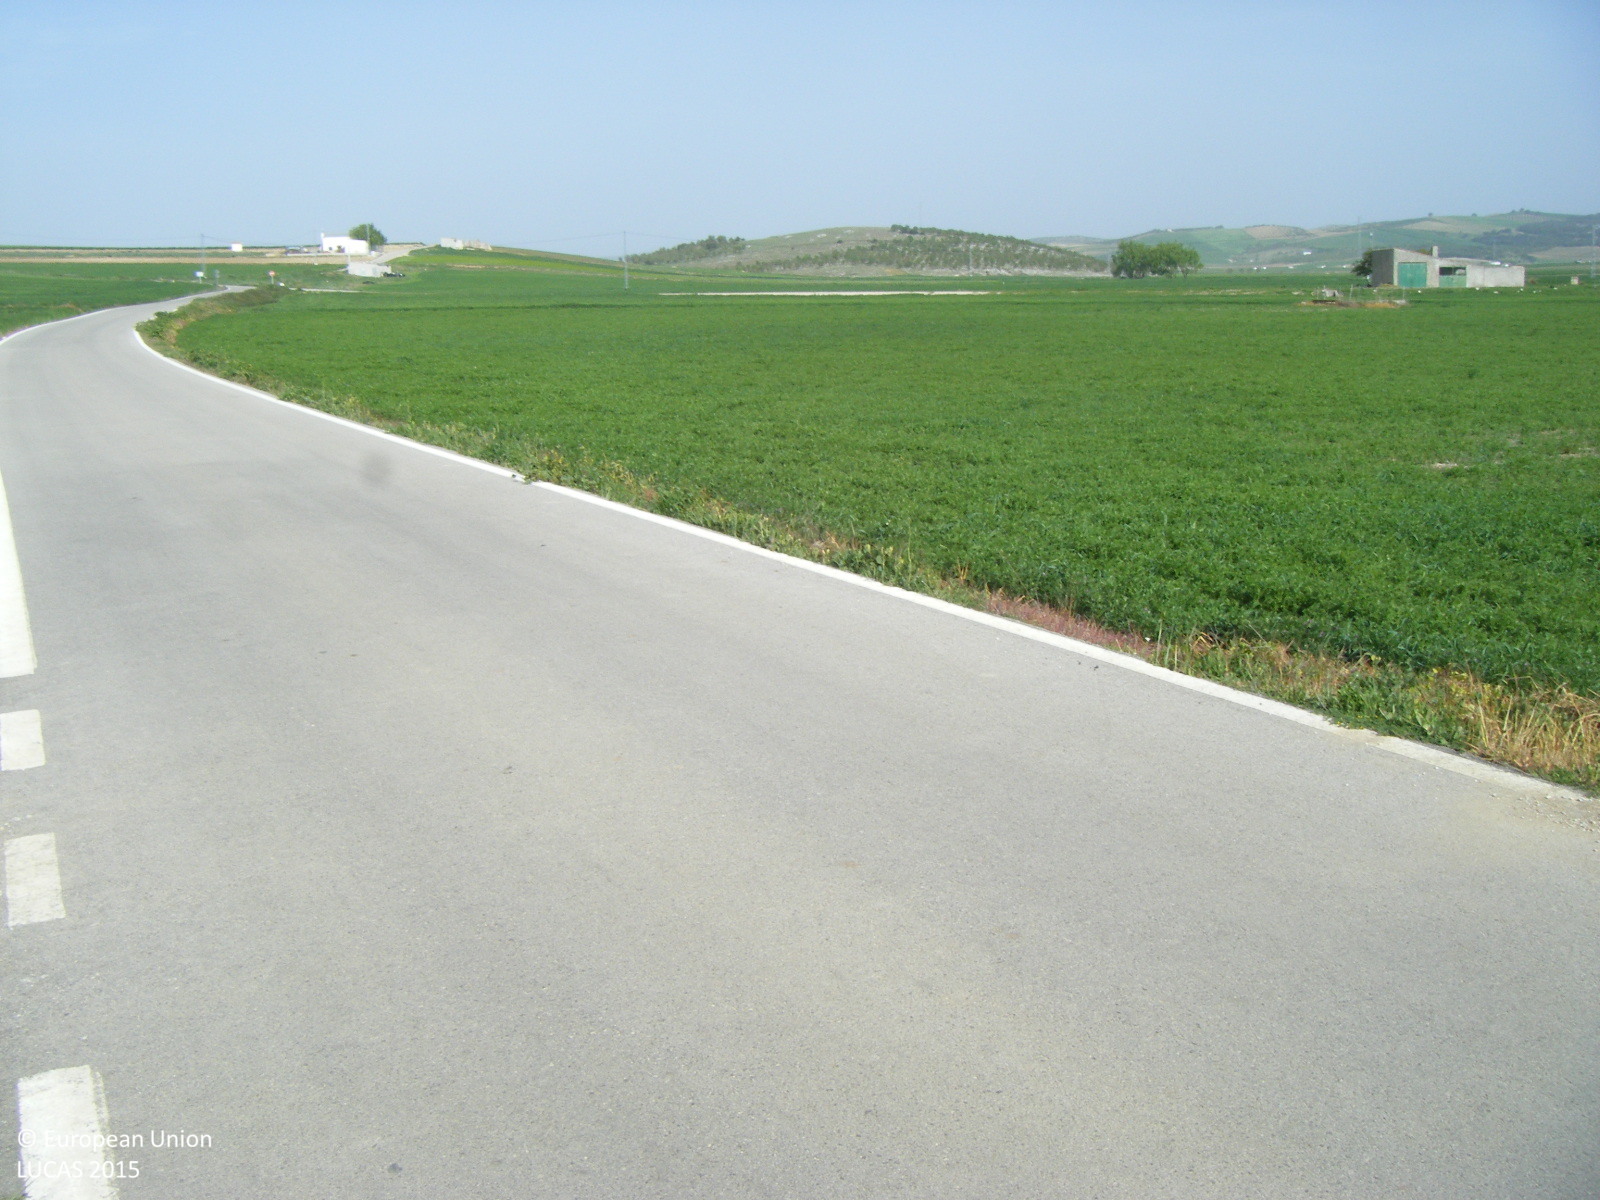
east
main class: Shrubland
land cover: Shrubland without tree cover
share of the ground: 50 - 75 %
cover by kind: shrubs 50 %, herbaceous plants 30 %, consolidated bare surface 20 %
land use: Agriculture (excluding fallow land and kitchen gardens)
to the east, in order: Shrubland without tree cover; Abandoned hedges; Arable land (only in case pi)
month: April
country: ES
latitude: 37.0290
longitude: -4.0541
